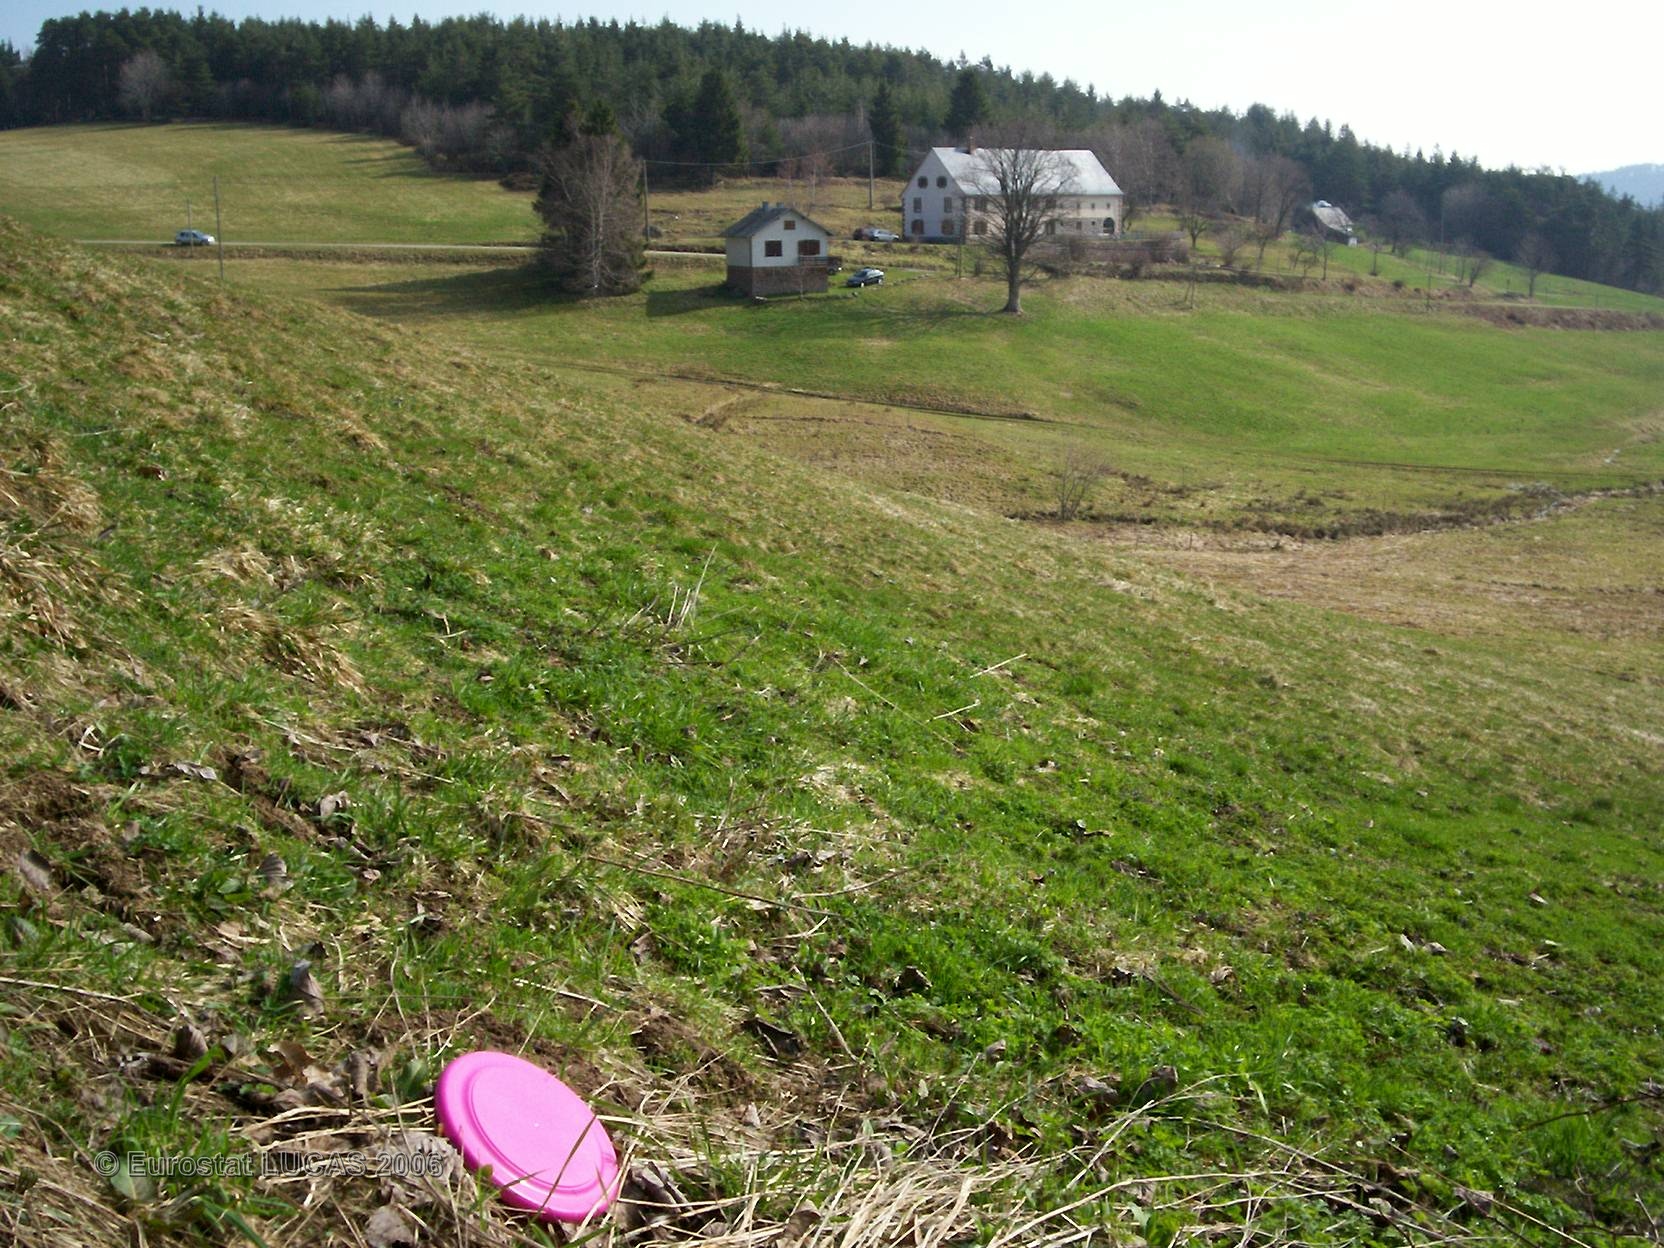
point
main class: Grassland
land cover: Grassland with sparse tree/shrub cover
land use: Agriculture (excluding fallow land and kitchen gardens)
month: April
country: FR
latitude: 48.0958
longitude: 7.1142
